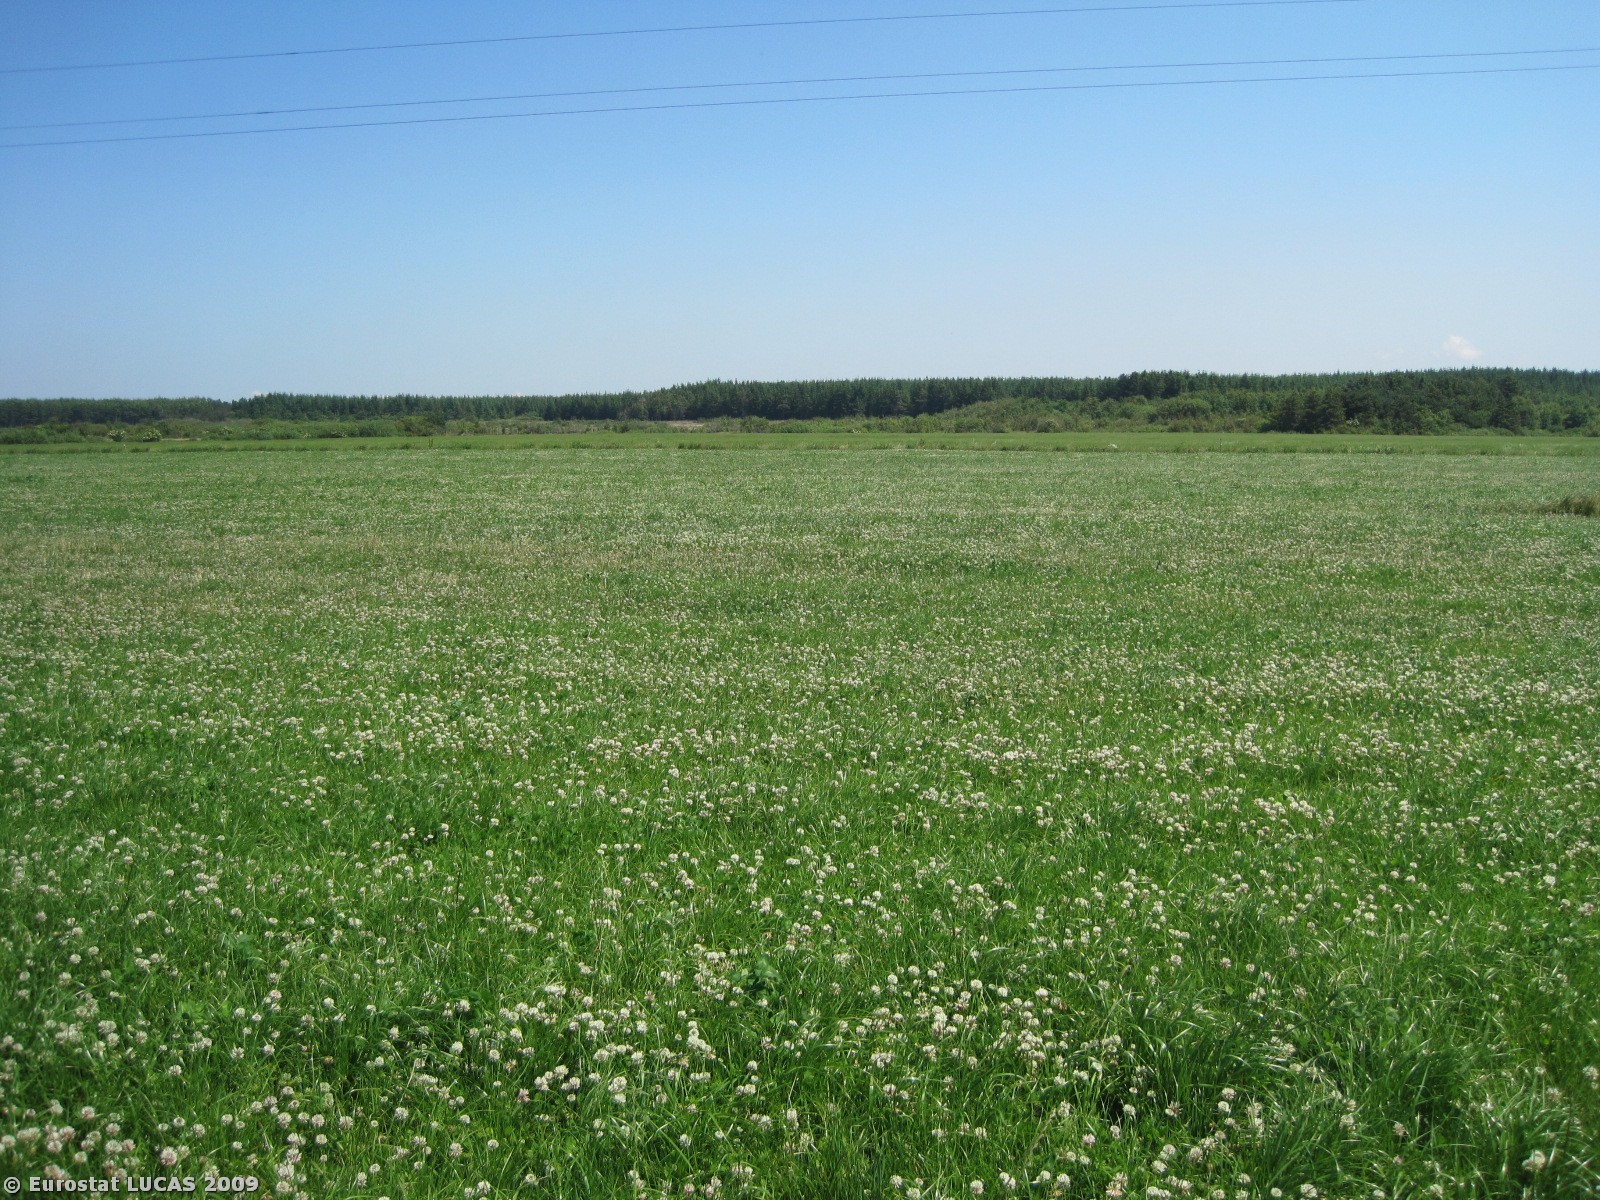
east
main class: Grassland
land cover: Grassland without tree/shrub cover
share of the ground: > 75 %
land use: Agriculture (excluding fallow land and kitchen gardens)
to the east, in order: Grassland without tree/shrub cover; Electric lines; Grassland without tree/shrub cover; Fences; Grass margins; Barley
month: July
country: DK
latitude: 56.4637
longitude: 8.2655
